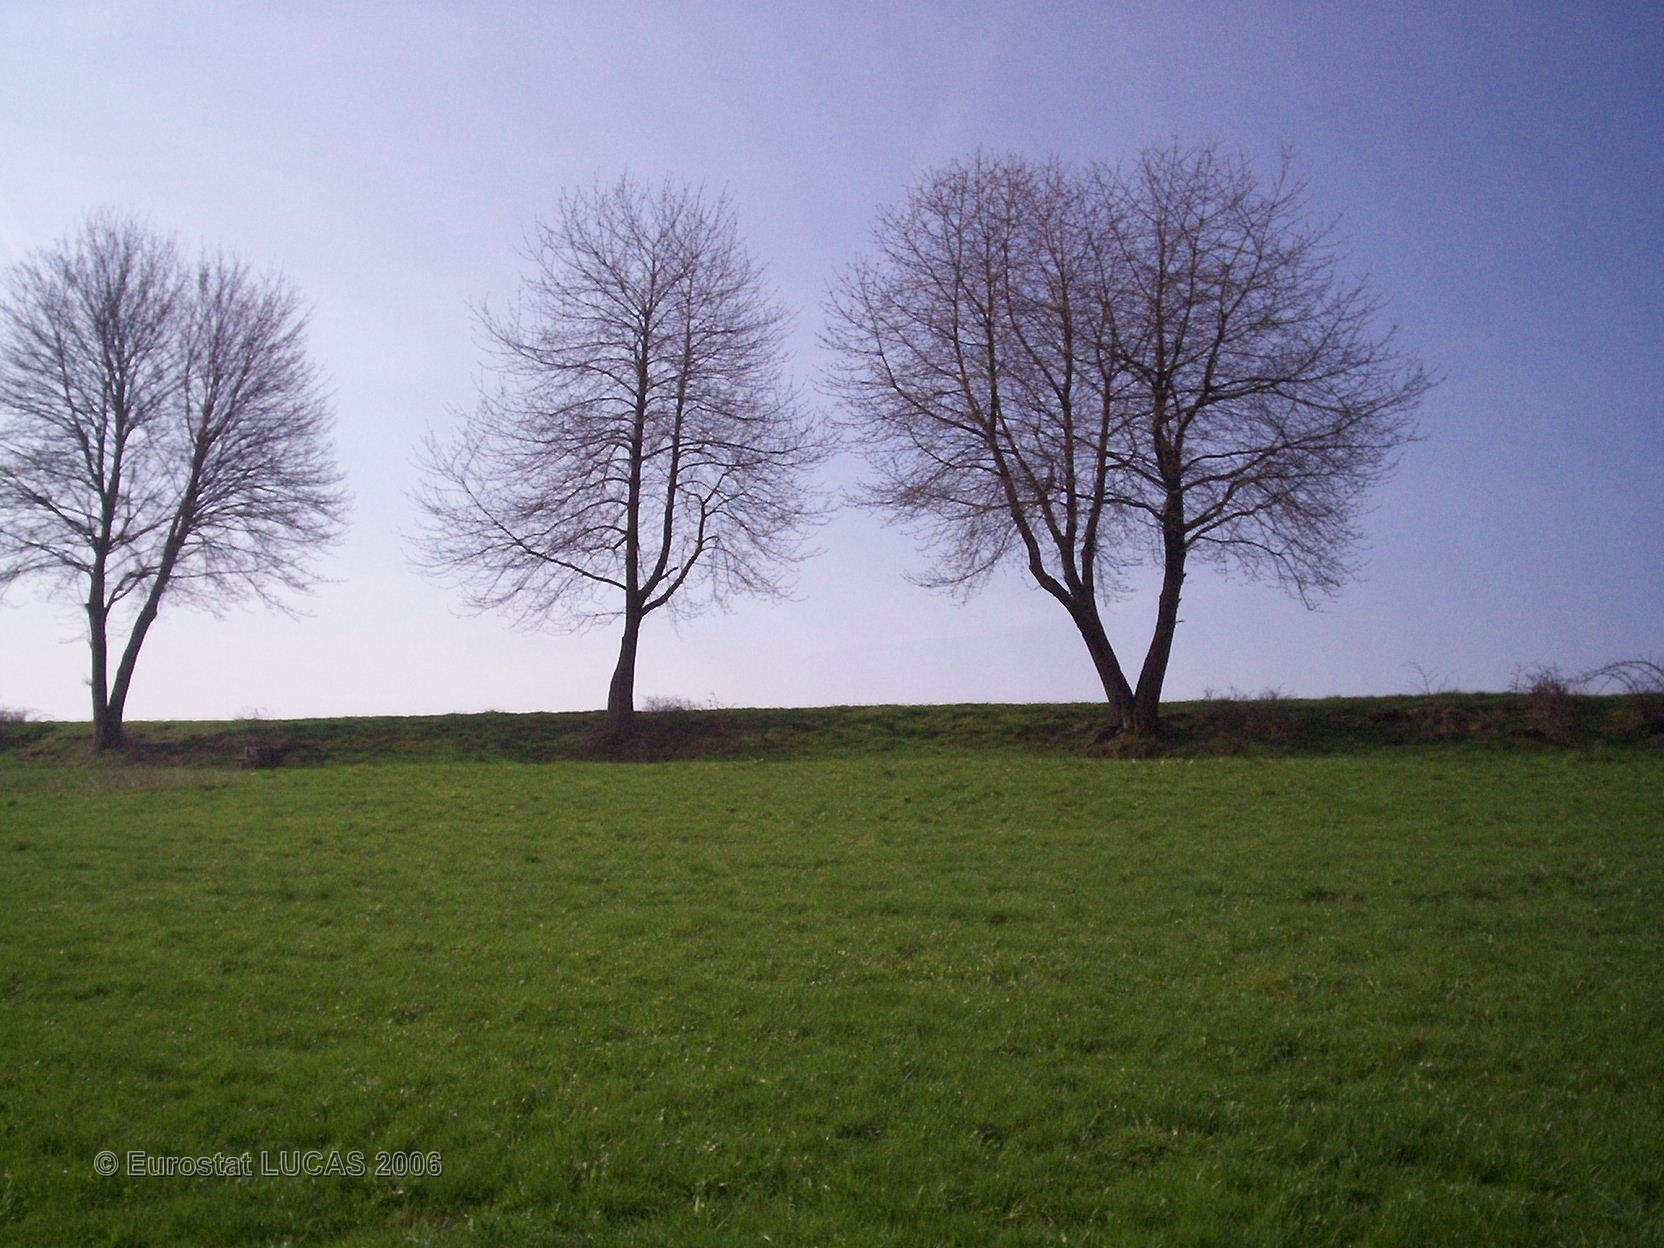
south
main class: Grassland
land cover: Grassland without tree/shrub cover
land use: Agriculture (excluding fallow land and kitchen gardens)
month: April
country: FR
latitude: 48.1625
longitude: 6.3302
